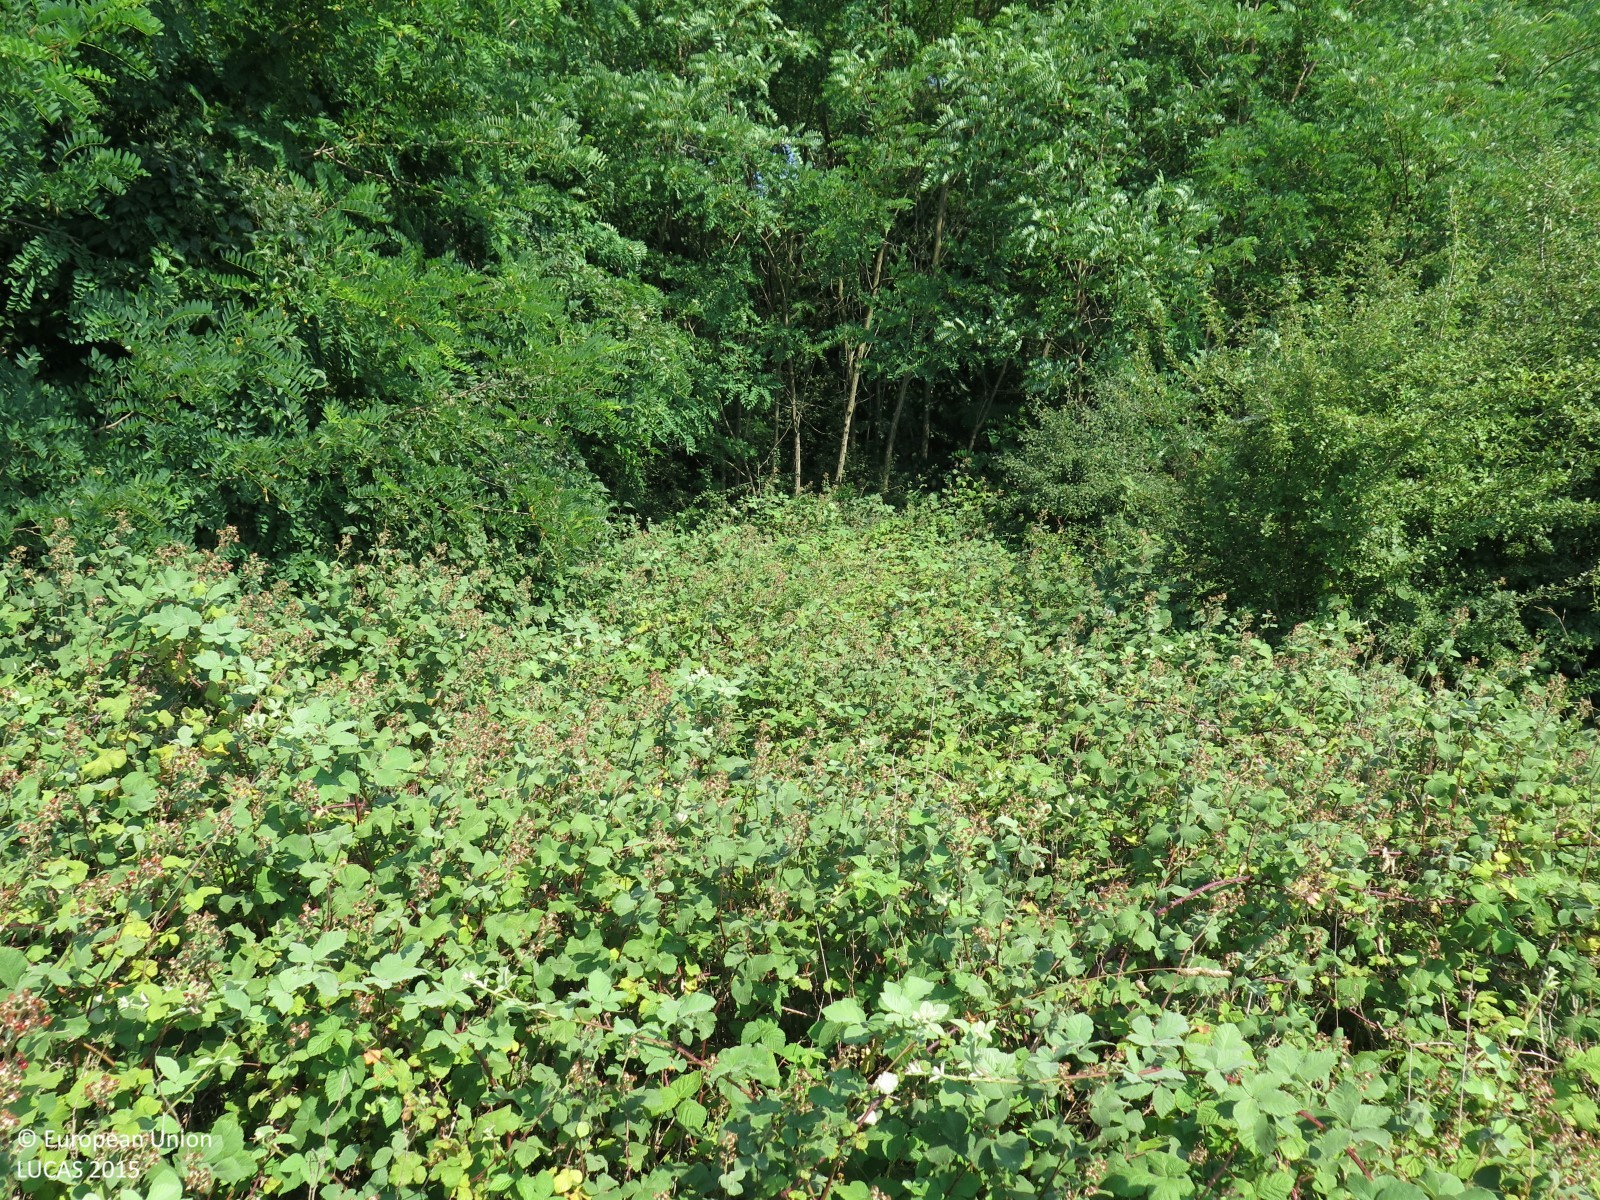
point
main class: Shrubland
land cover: Shrubland with sparse tree cover
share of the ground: > 75 %
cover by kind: shrubs 90 %, broadleaved forest trees 5 %, herbaceous plants 5 %
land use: Semi-natural and natural areas not in use
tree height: > 5 m
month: July
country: HR
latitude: 45.4820
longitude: 13.5136
